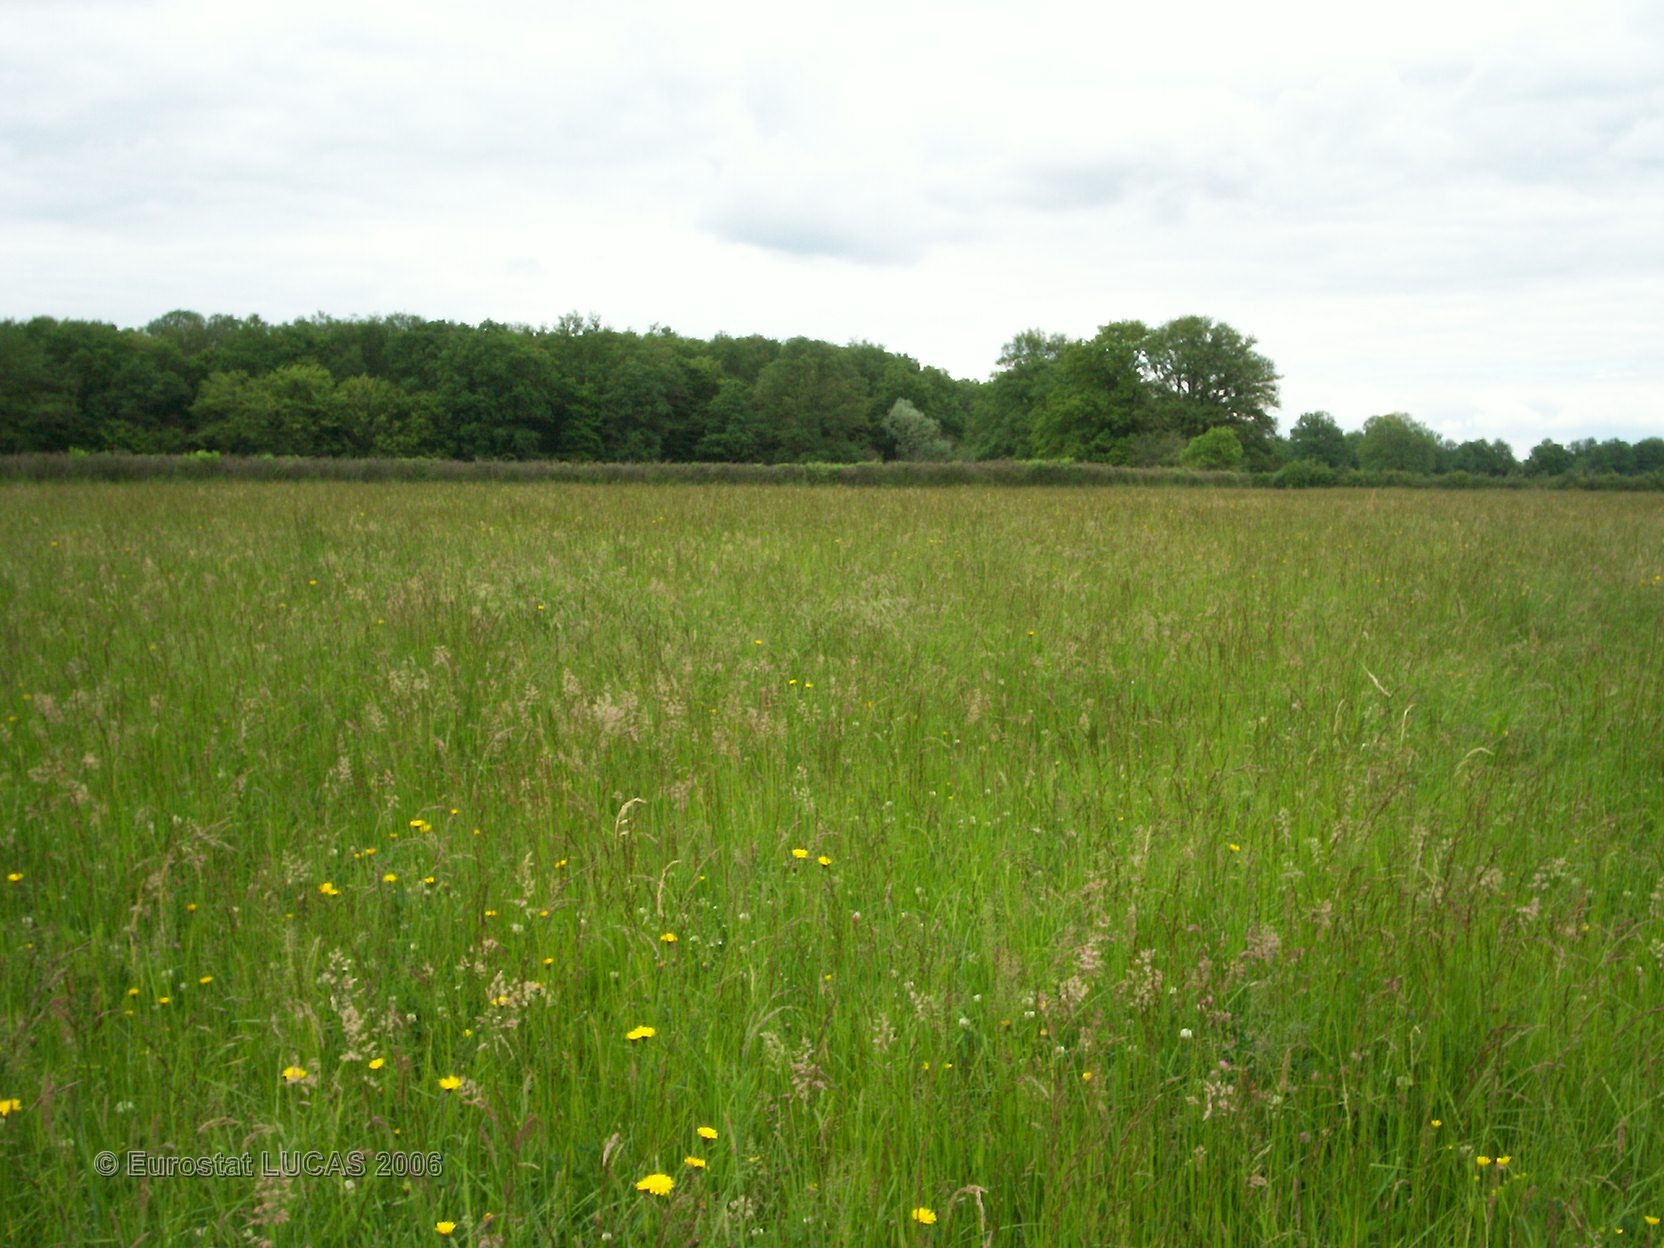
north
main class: Grassland
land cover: Grassland without tree/shrub cover
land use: Agriculture (excluding fallow land and kitchen gardens)
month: May
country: FR
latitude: 46.8648
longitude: 3.0304
